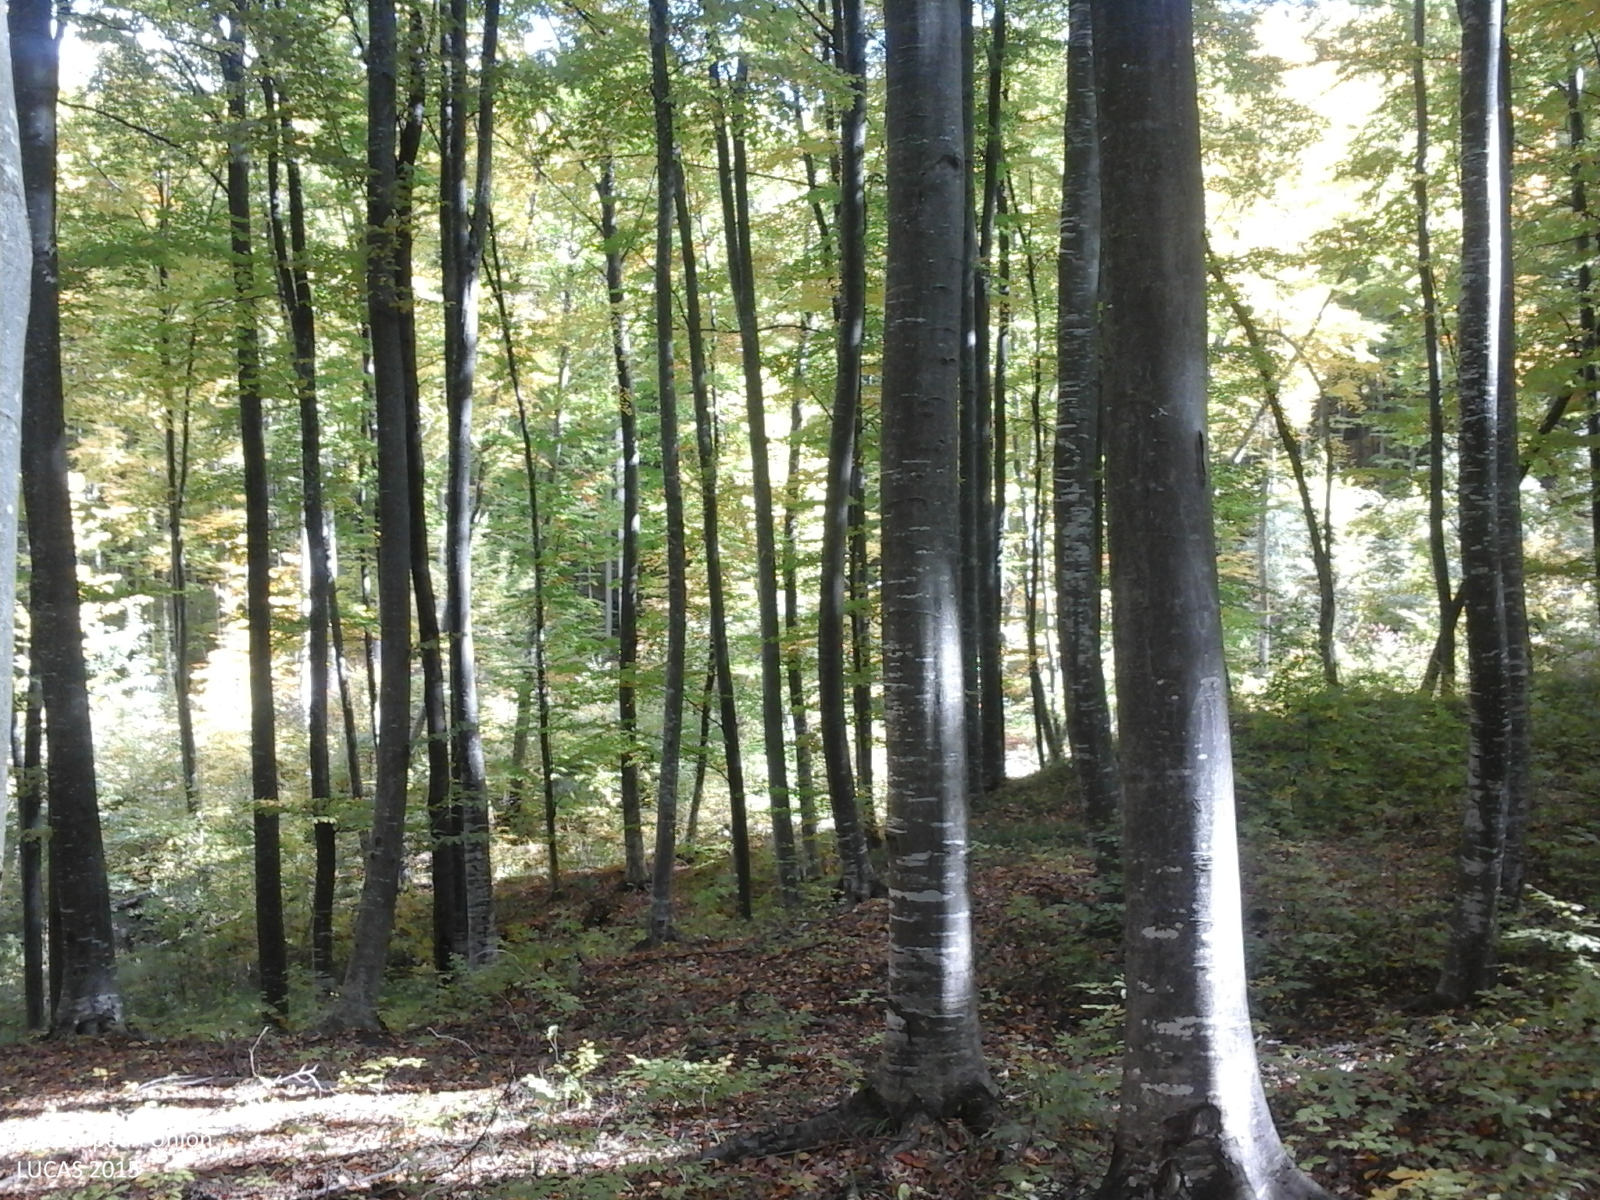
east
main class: Woodland
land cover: Broadleaved woodland
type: mesophytic deciduous forest
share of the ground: > 75 %
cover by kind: broadleaved forest trees 100 %
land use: Forestry
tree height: > 5 m
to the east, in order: Broadleaved woodland; Rivers and streams; Broadleaved woodland; Tracks; Broadleaved woodland; Tracks; Broadleaved woodland
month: October
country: RO
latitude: 45.1762
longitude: 25.7426
